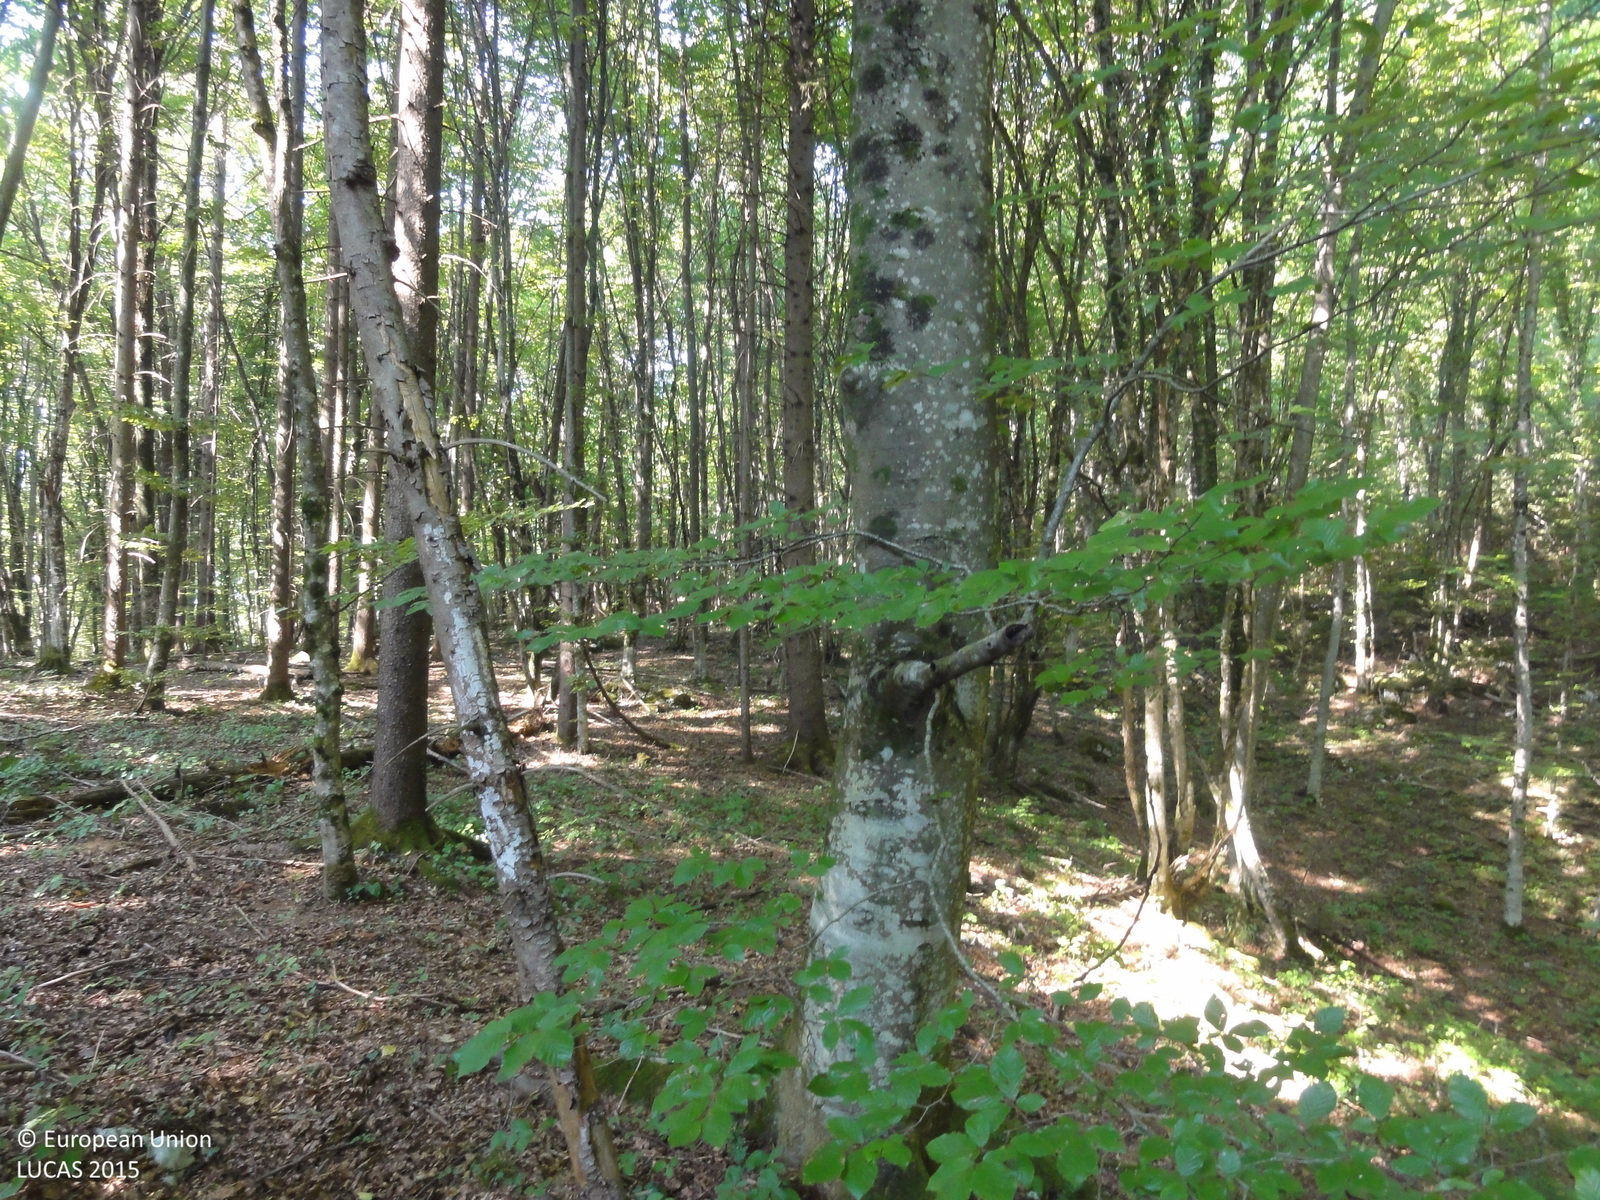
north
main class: Woodland
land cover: Broadleaved woodland
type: beech forest
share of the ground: > 75 %
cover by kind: broadleaved forest trees 85 %, coniferous forest trees 15 %
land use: Forestry
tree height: > 5 m
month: August
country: SI
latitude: 45.8346
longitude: 15.0560
